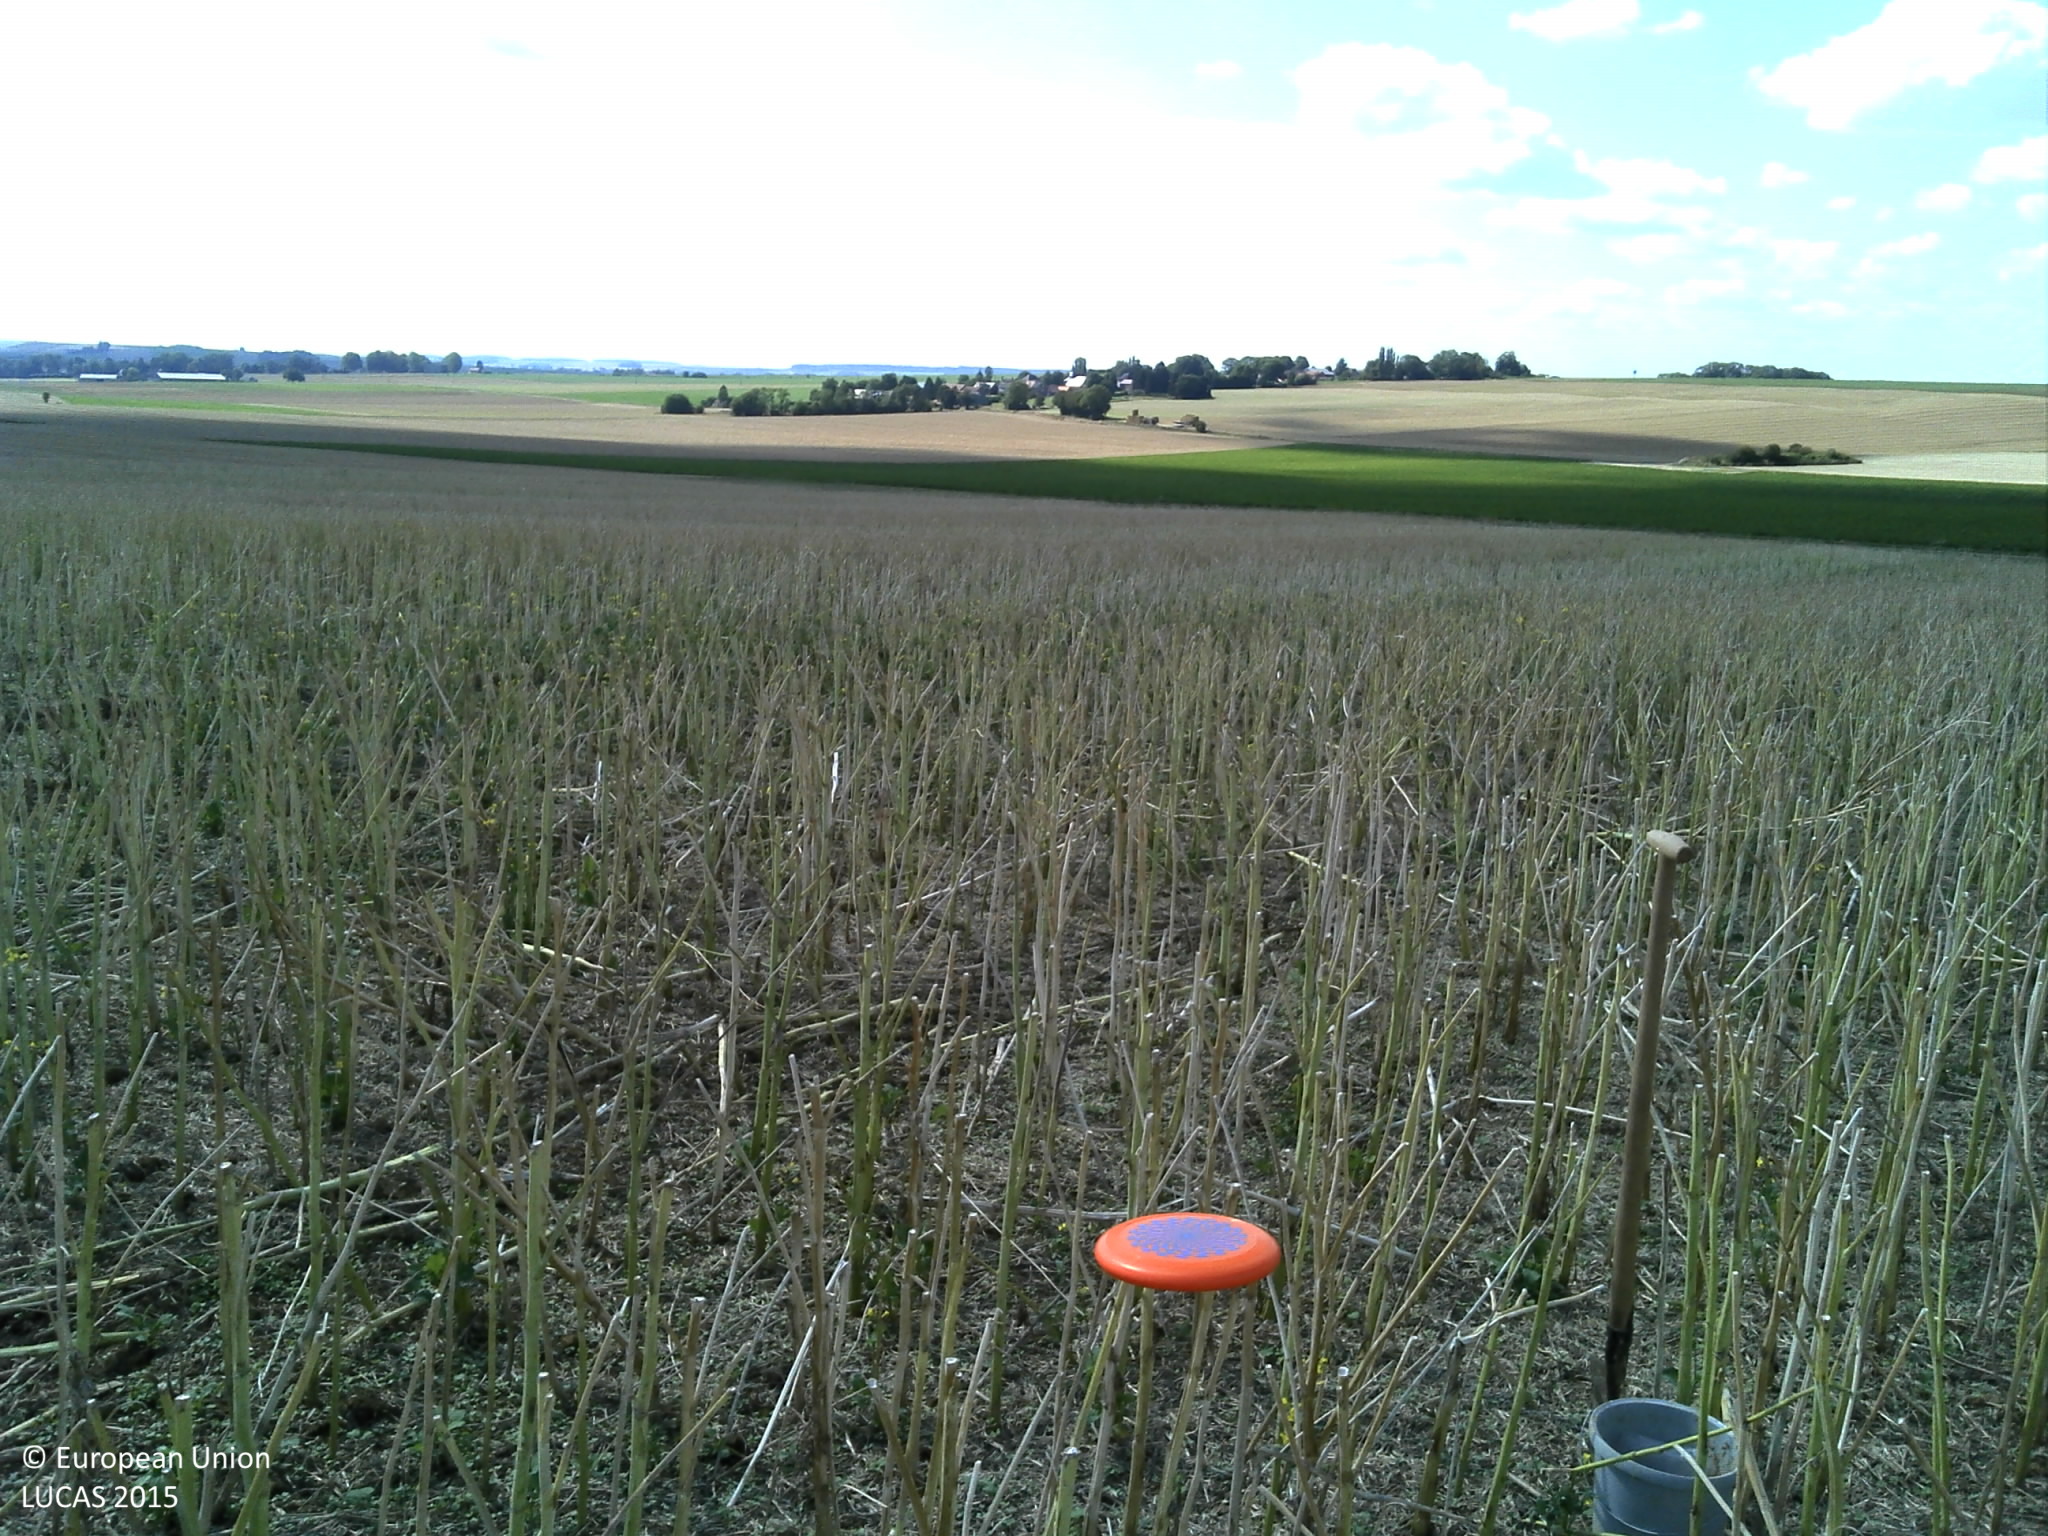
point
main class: Cropland
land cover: Rape and turnip rape
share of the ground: 10 - 25 %
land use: Agriculture (excluding fallow land and kitchen gardens)
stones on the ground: < 10 %
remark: Harvested field
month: August
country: FR
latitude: 49.9420
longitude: 3.1492
